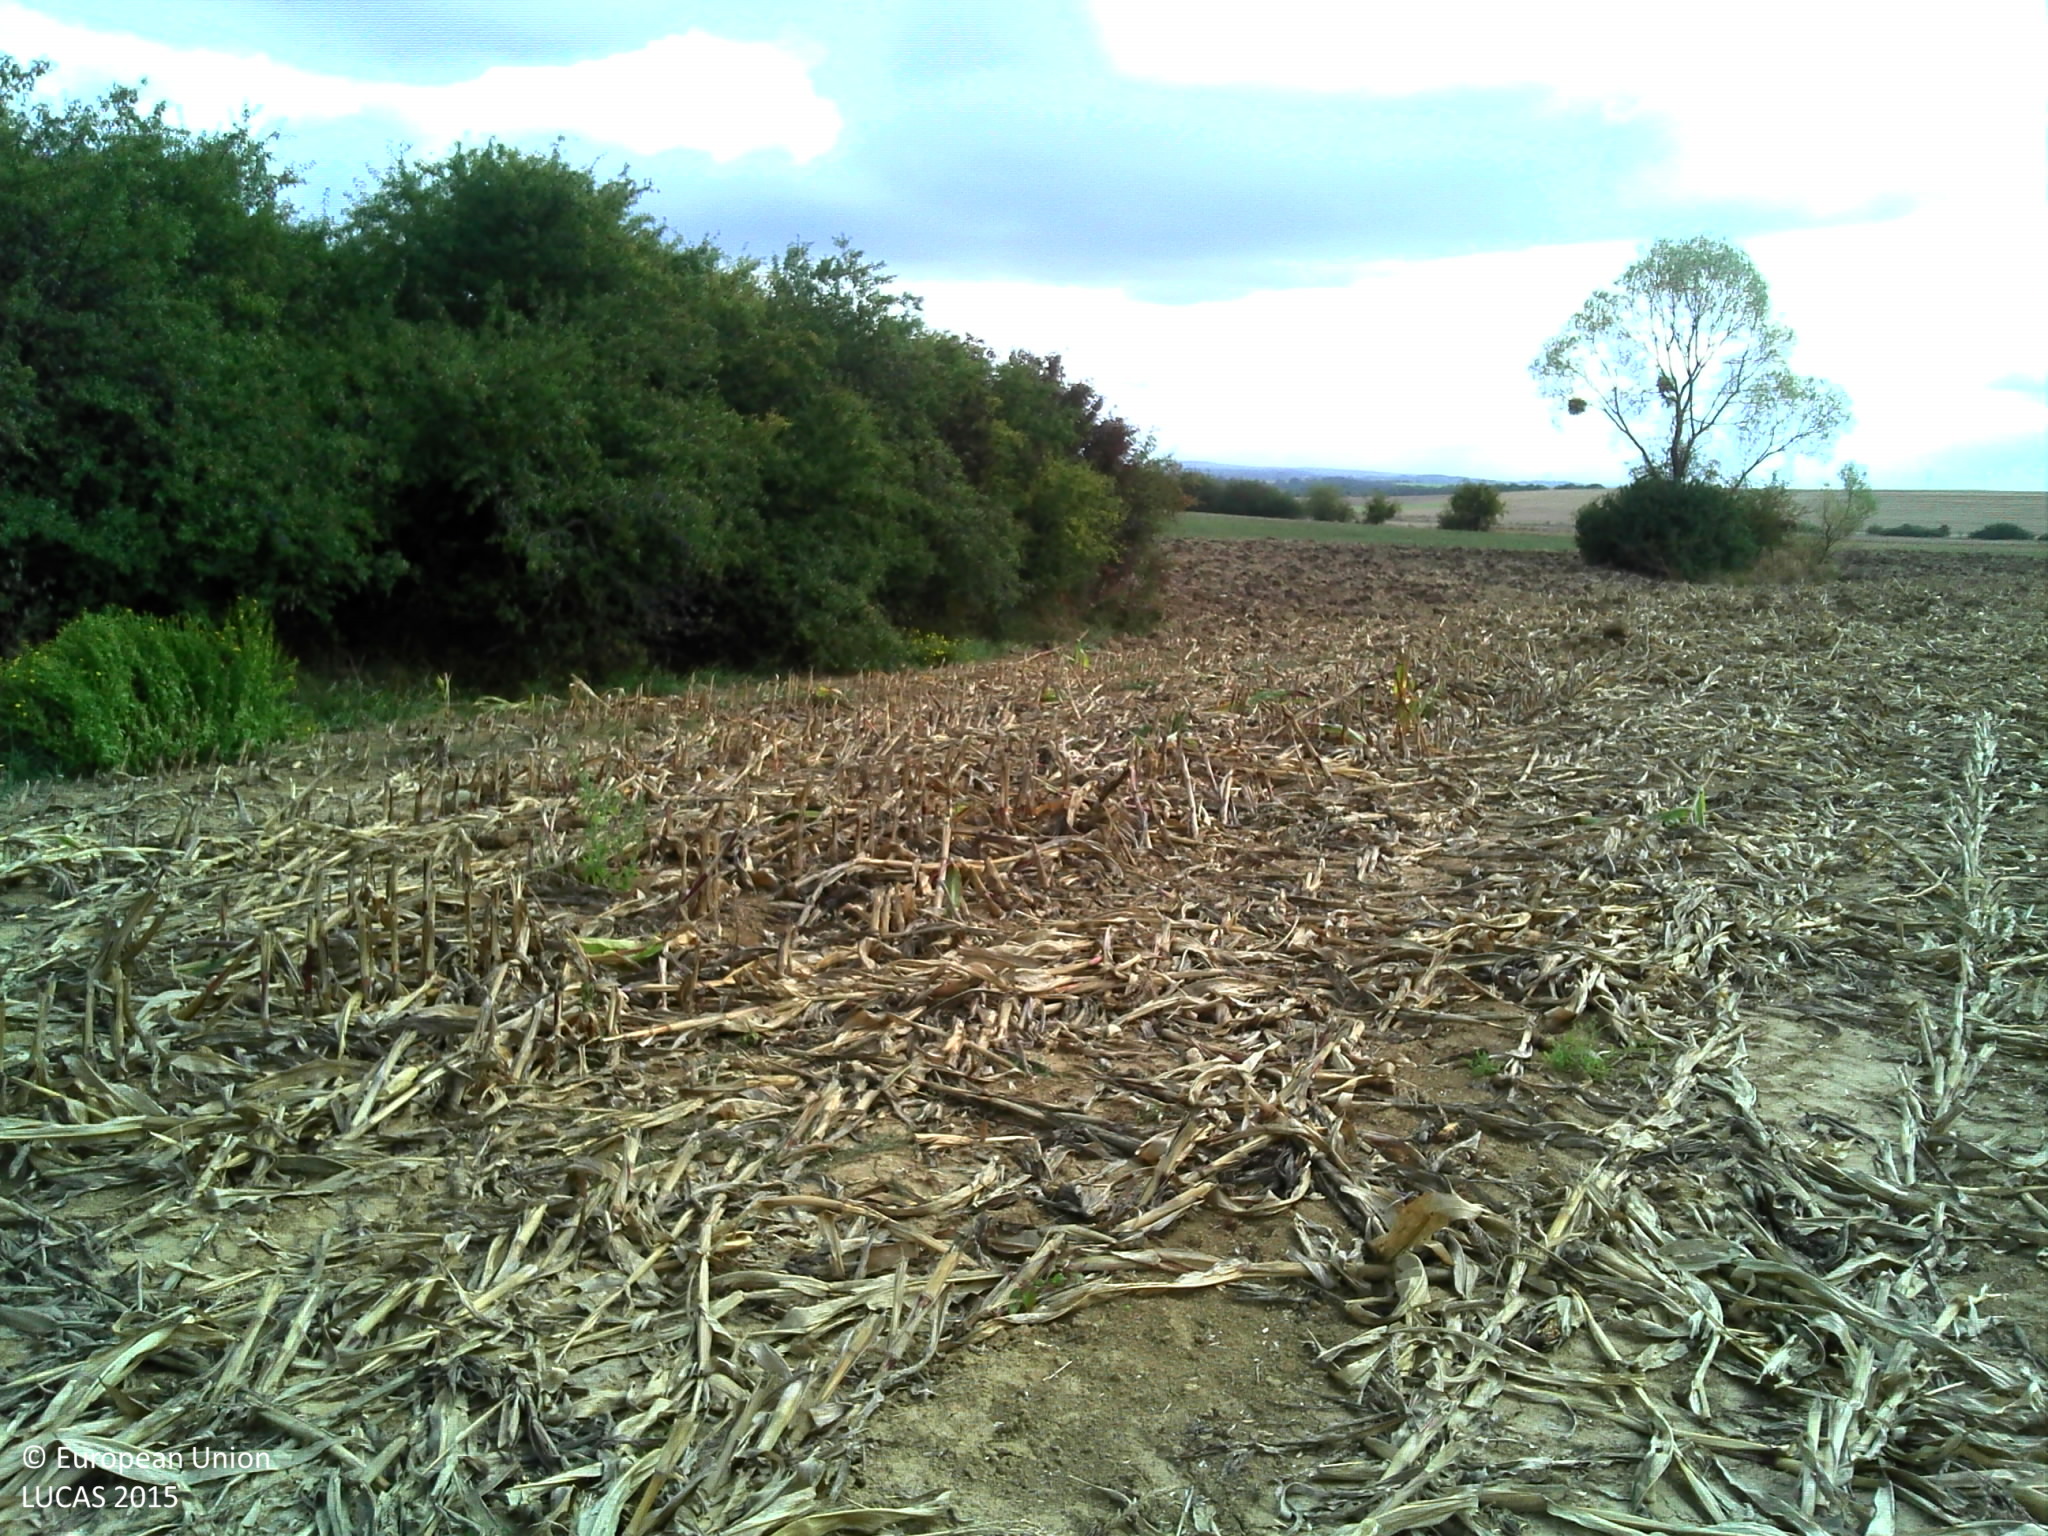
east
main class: Cropland
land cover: Maize
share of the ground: < 10 %
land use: Agriculture (excluding fallow land and kitchen gardens)
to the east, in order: Maize; Grassland without tree/shrub cover; Other bare soil; Grassland without tree/shrub cover; Abandoned hedges; Fences; Grass margins; Maize
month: September
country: FR
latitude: 48.5494
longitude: 6.0579
